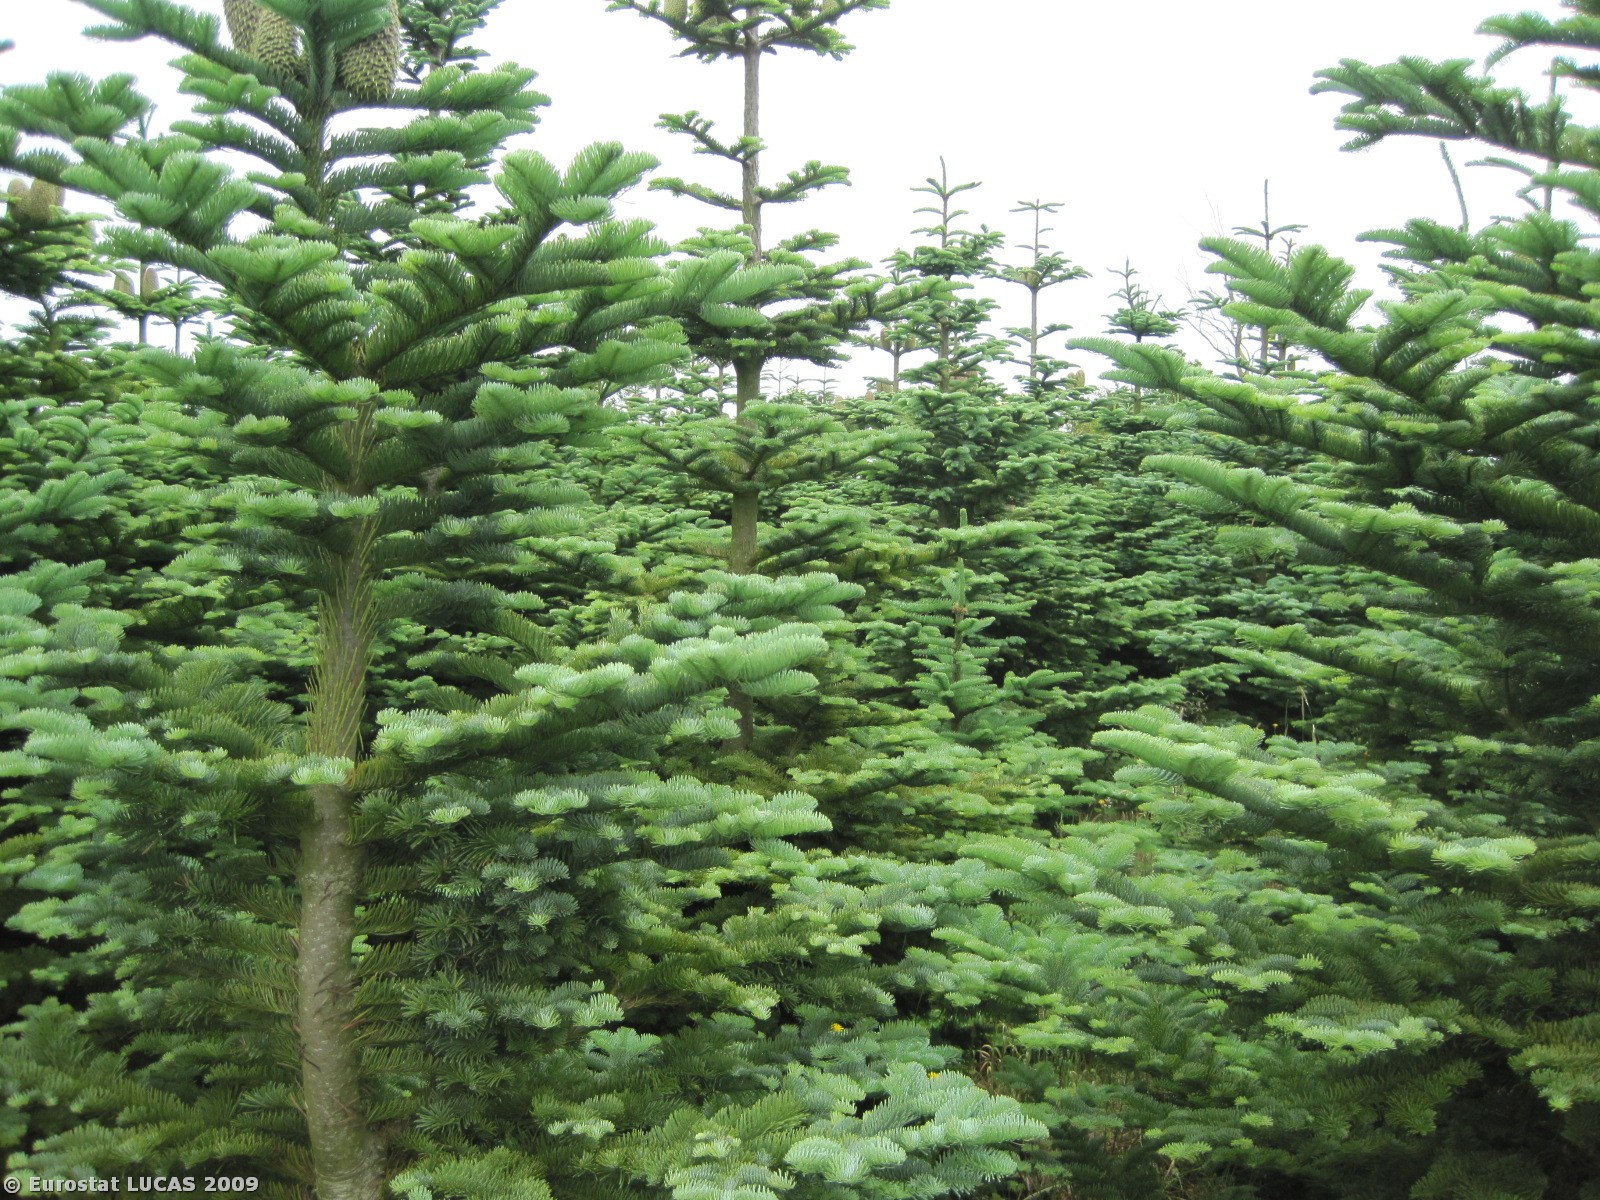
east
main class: Woodland
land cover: Coniferous woodland
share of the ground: 50 - 75 %
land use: Forestry
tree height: > 5 m
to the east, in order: Coniferous woodland; Grassland without tree/shrub cover; Coniferous woodland; Grassland without tree/shrub cover; Broadleaved woodland; Grass margins; Barley; Oats
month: June
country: DK
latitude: 56.3216
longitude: 8.4011
